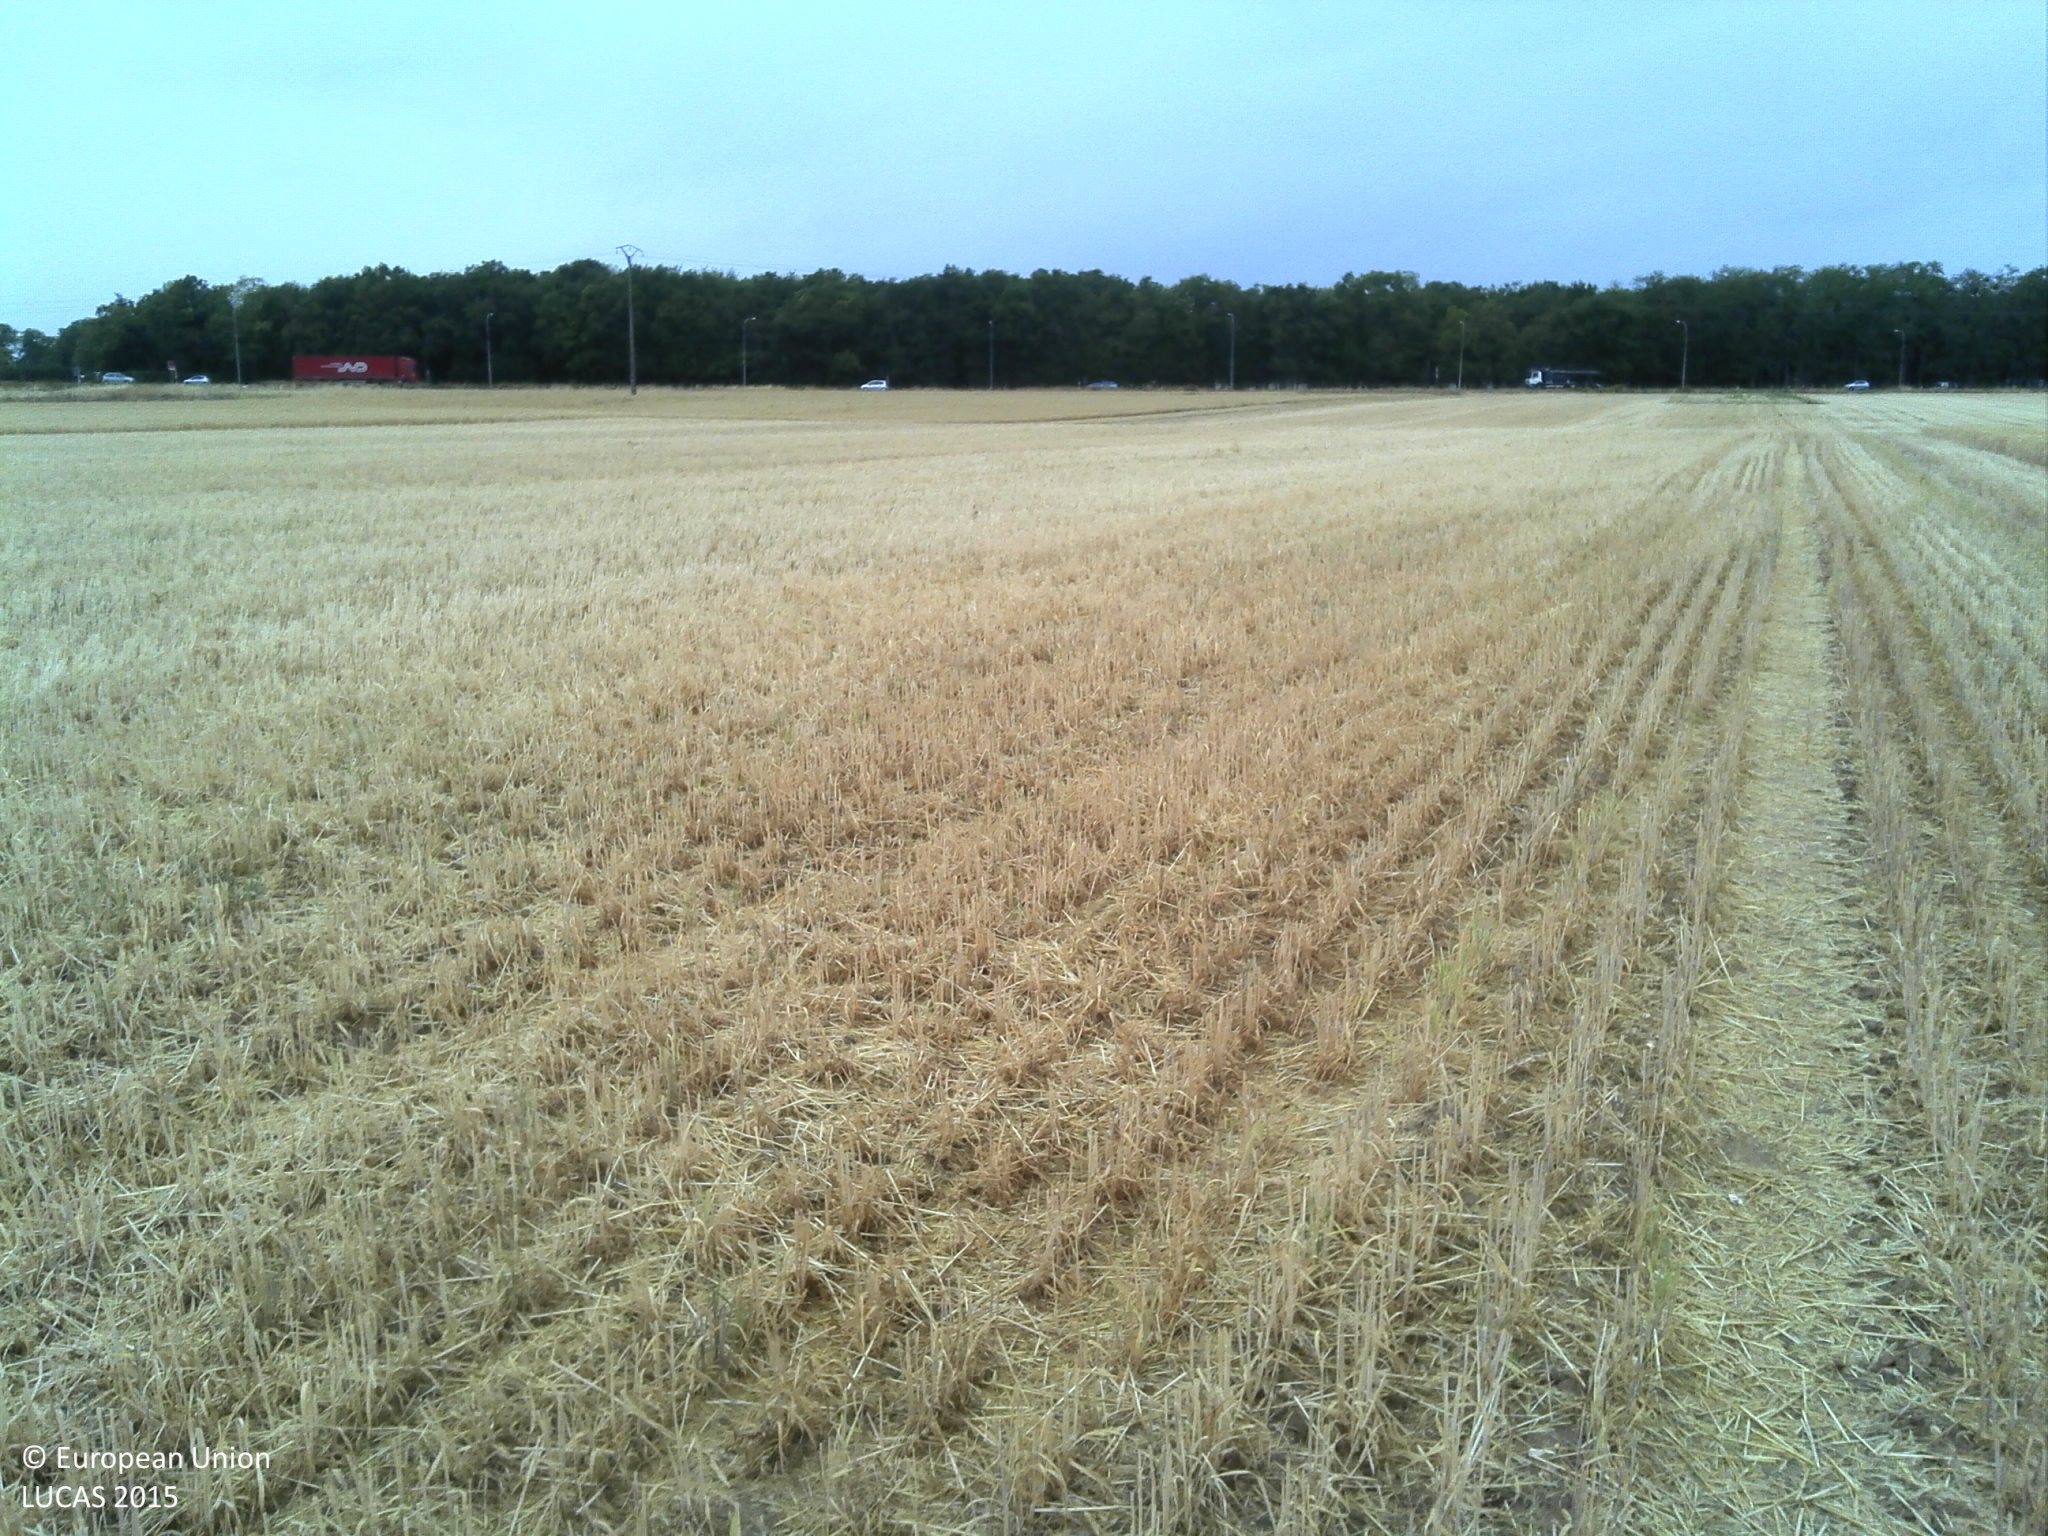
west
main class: Cropland
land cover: Barley
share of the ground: > 75 %
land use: Agriculture (excluding fallow land and kitchen gardens)
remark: Harvested field
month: July
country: FR
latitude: 48.9727
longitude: 1.8837
